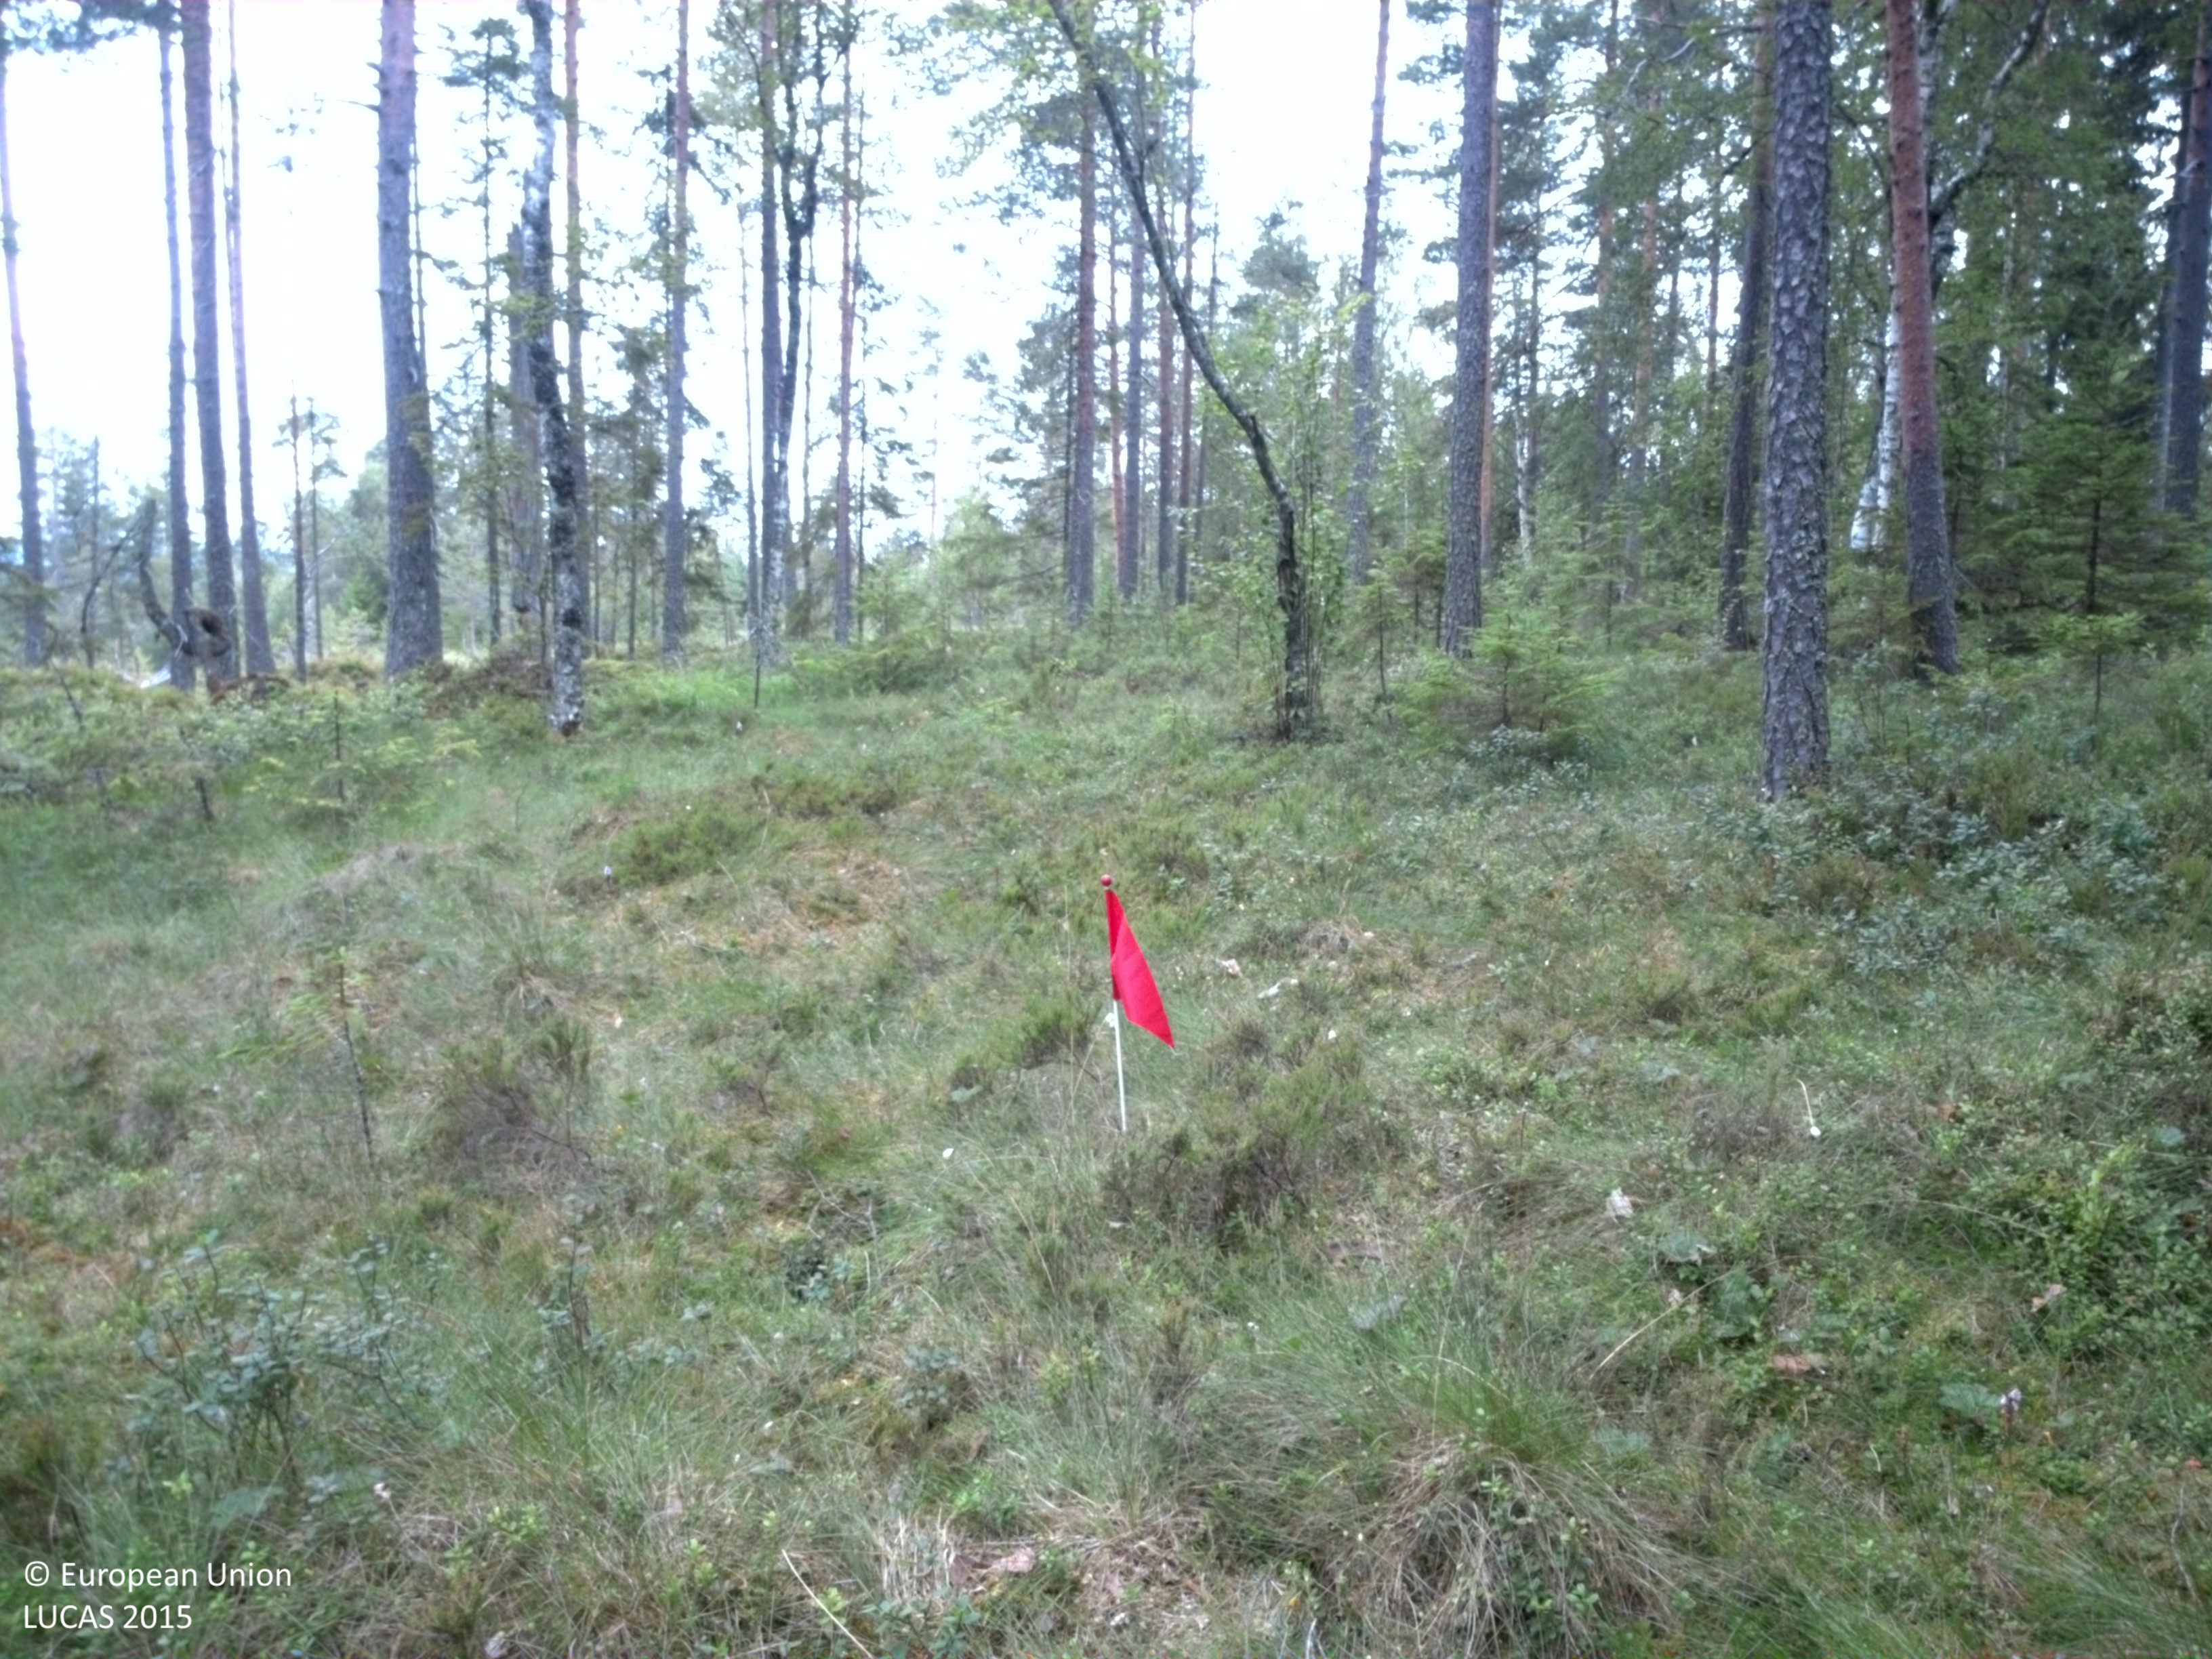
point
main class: Woodland
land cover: Pine dominated coniferous woodland
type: boreal forest
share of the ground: 25 - 50 %
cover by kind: coniferous forest trees 45 %, lichens and mosses 25 %, herbaceous plants 15 %, shrubs 10 %, broadleaved forest trees 5 %
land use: Forestry
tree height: > 5 m
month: August
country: SE
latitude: 60.3520
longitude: 13.5602
